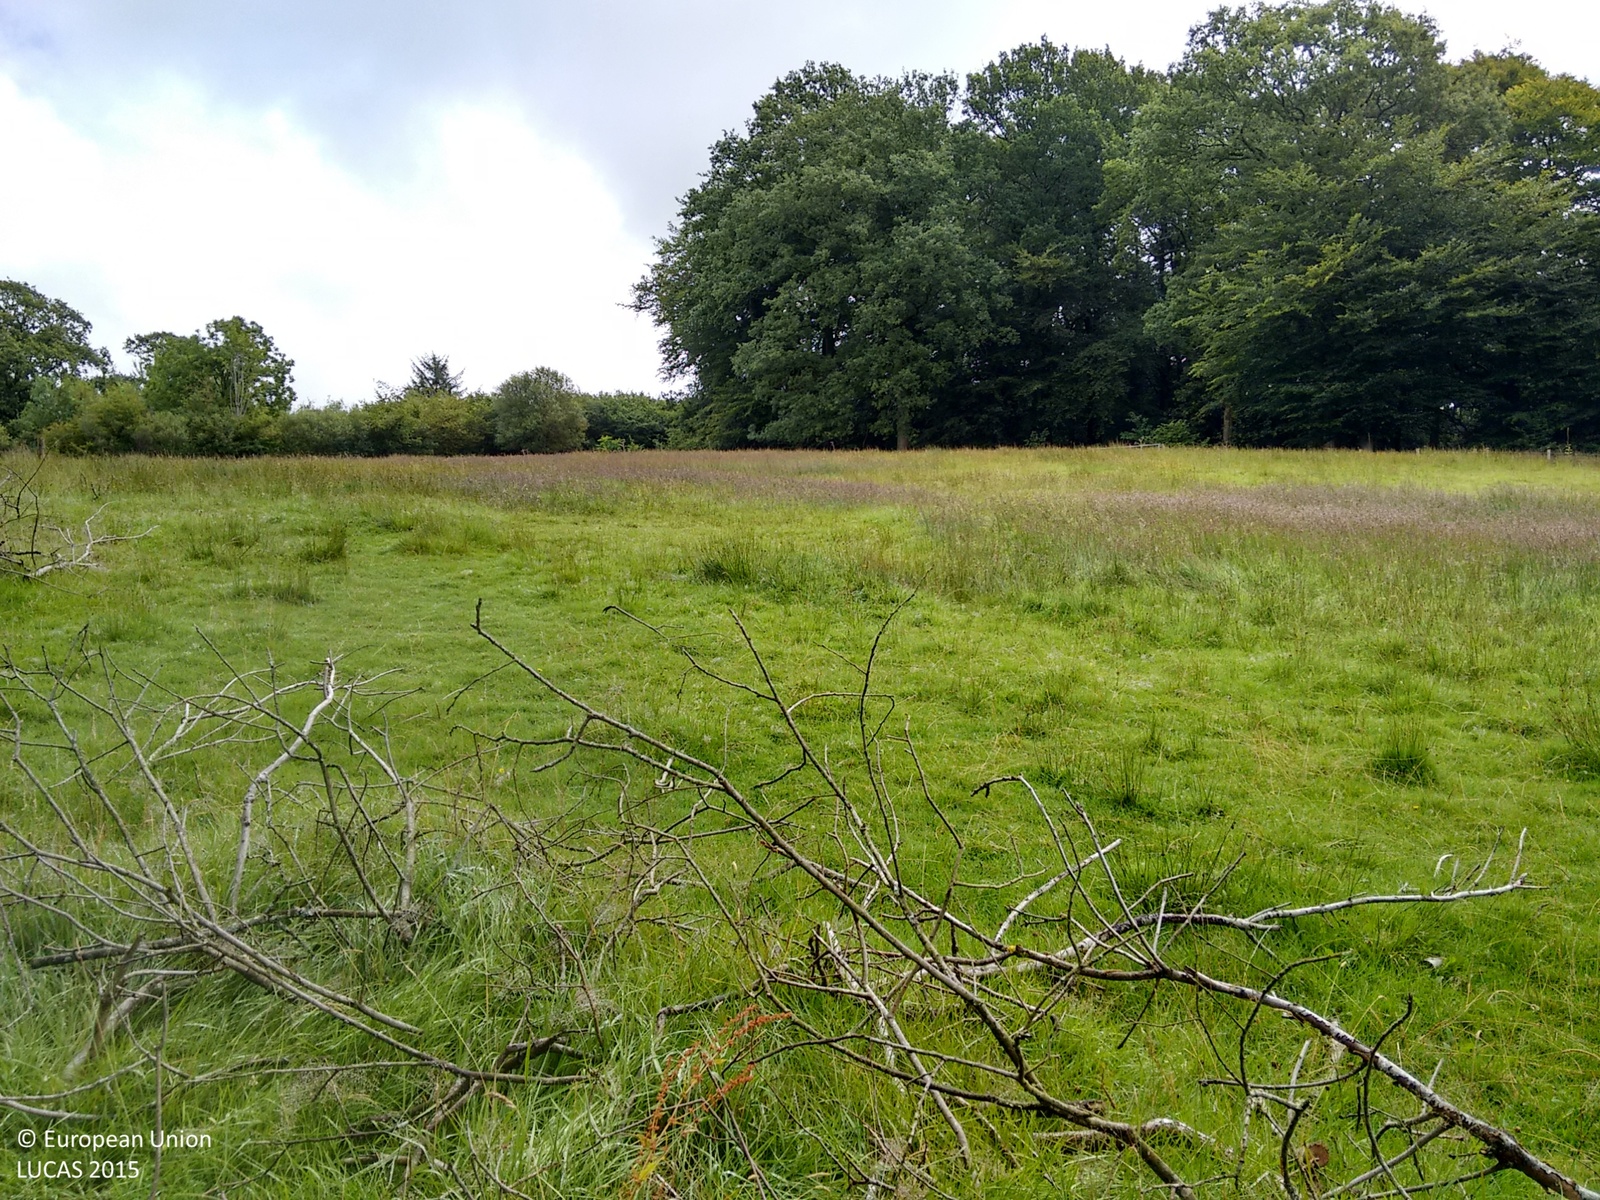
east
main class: Grassland
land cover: Grassland without tree/shrub cover
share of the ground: > 75 %
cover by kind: herbaceous plants 100 %
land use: Agriculture (excluding fallow land and kitchen gardens)
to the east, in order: Grassland without tree/shrub cover; Fences; Broadleaved woodland; Managed hedges; Fences; Managed hedges; Tracks; Electric lines; Managed hedges; Fences; Shrubland without tree cover; Managed hedges; Fences; Managed hedges; Grassland without tree/shrub cover
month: August
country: GB
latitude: 51.9175
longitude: -4.0681
